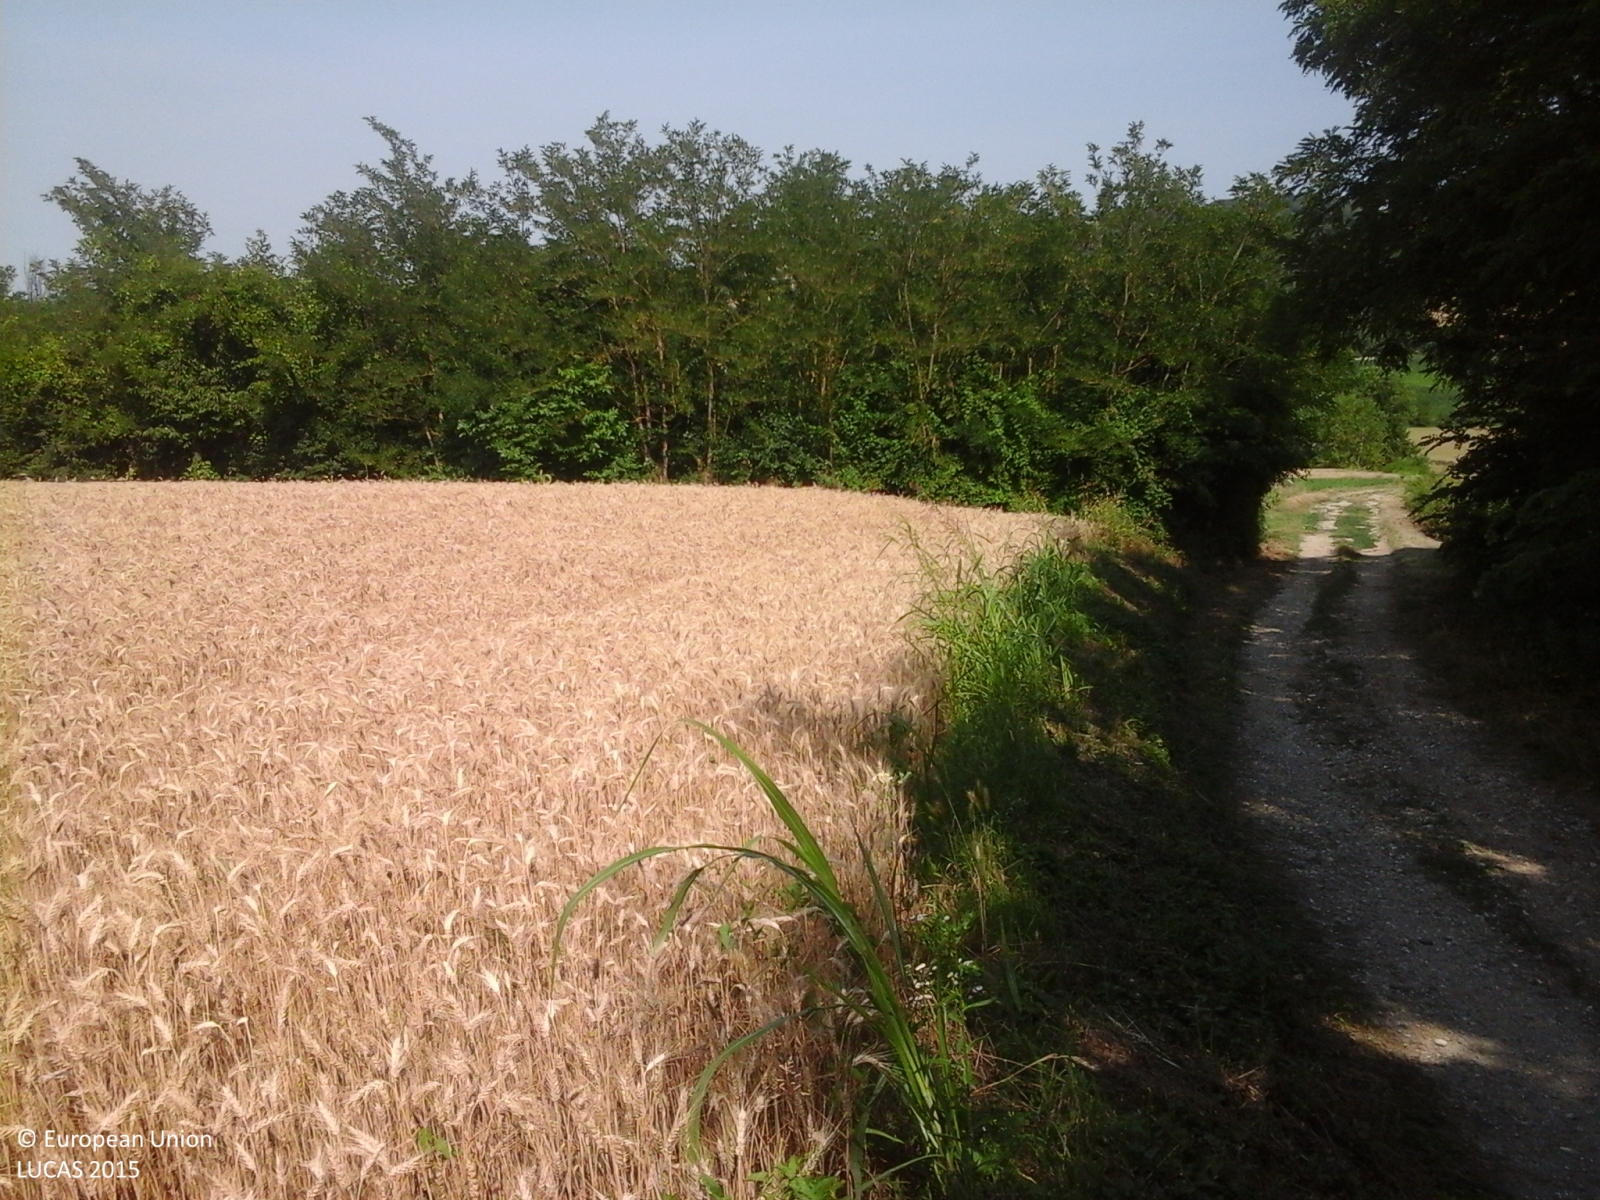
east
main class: Cropland
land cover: Common wheat
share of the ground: > 75 %
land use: Agriculture (excluding fallow land and kitchen gardens)
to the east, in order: Common wheat; Broadleaved woodland; Clovers; Triticale; Managed hedges; Ditches and canals; Tracks; Common wheat; Broadleaved woodland
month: June
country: IT
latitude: 45.0062
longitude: 8.4424
